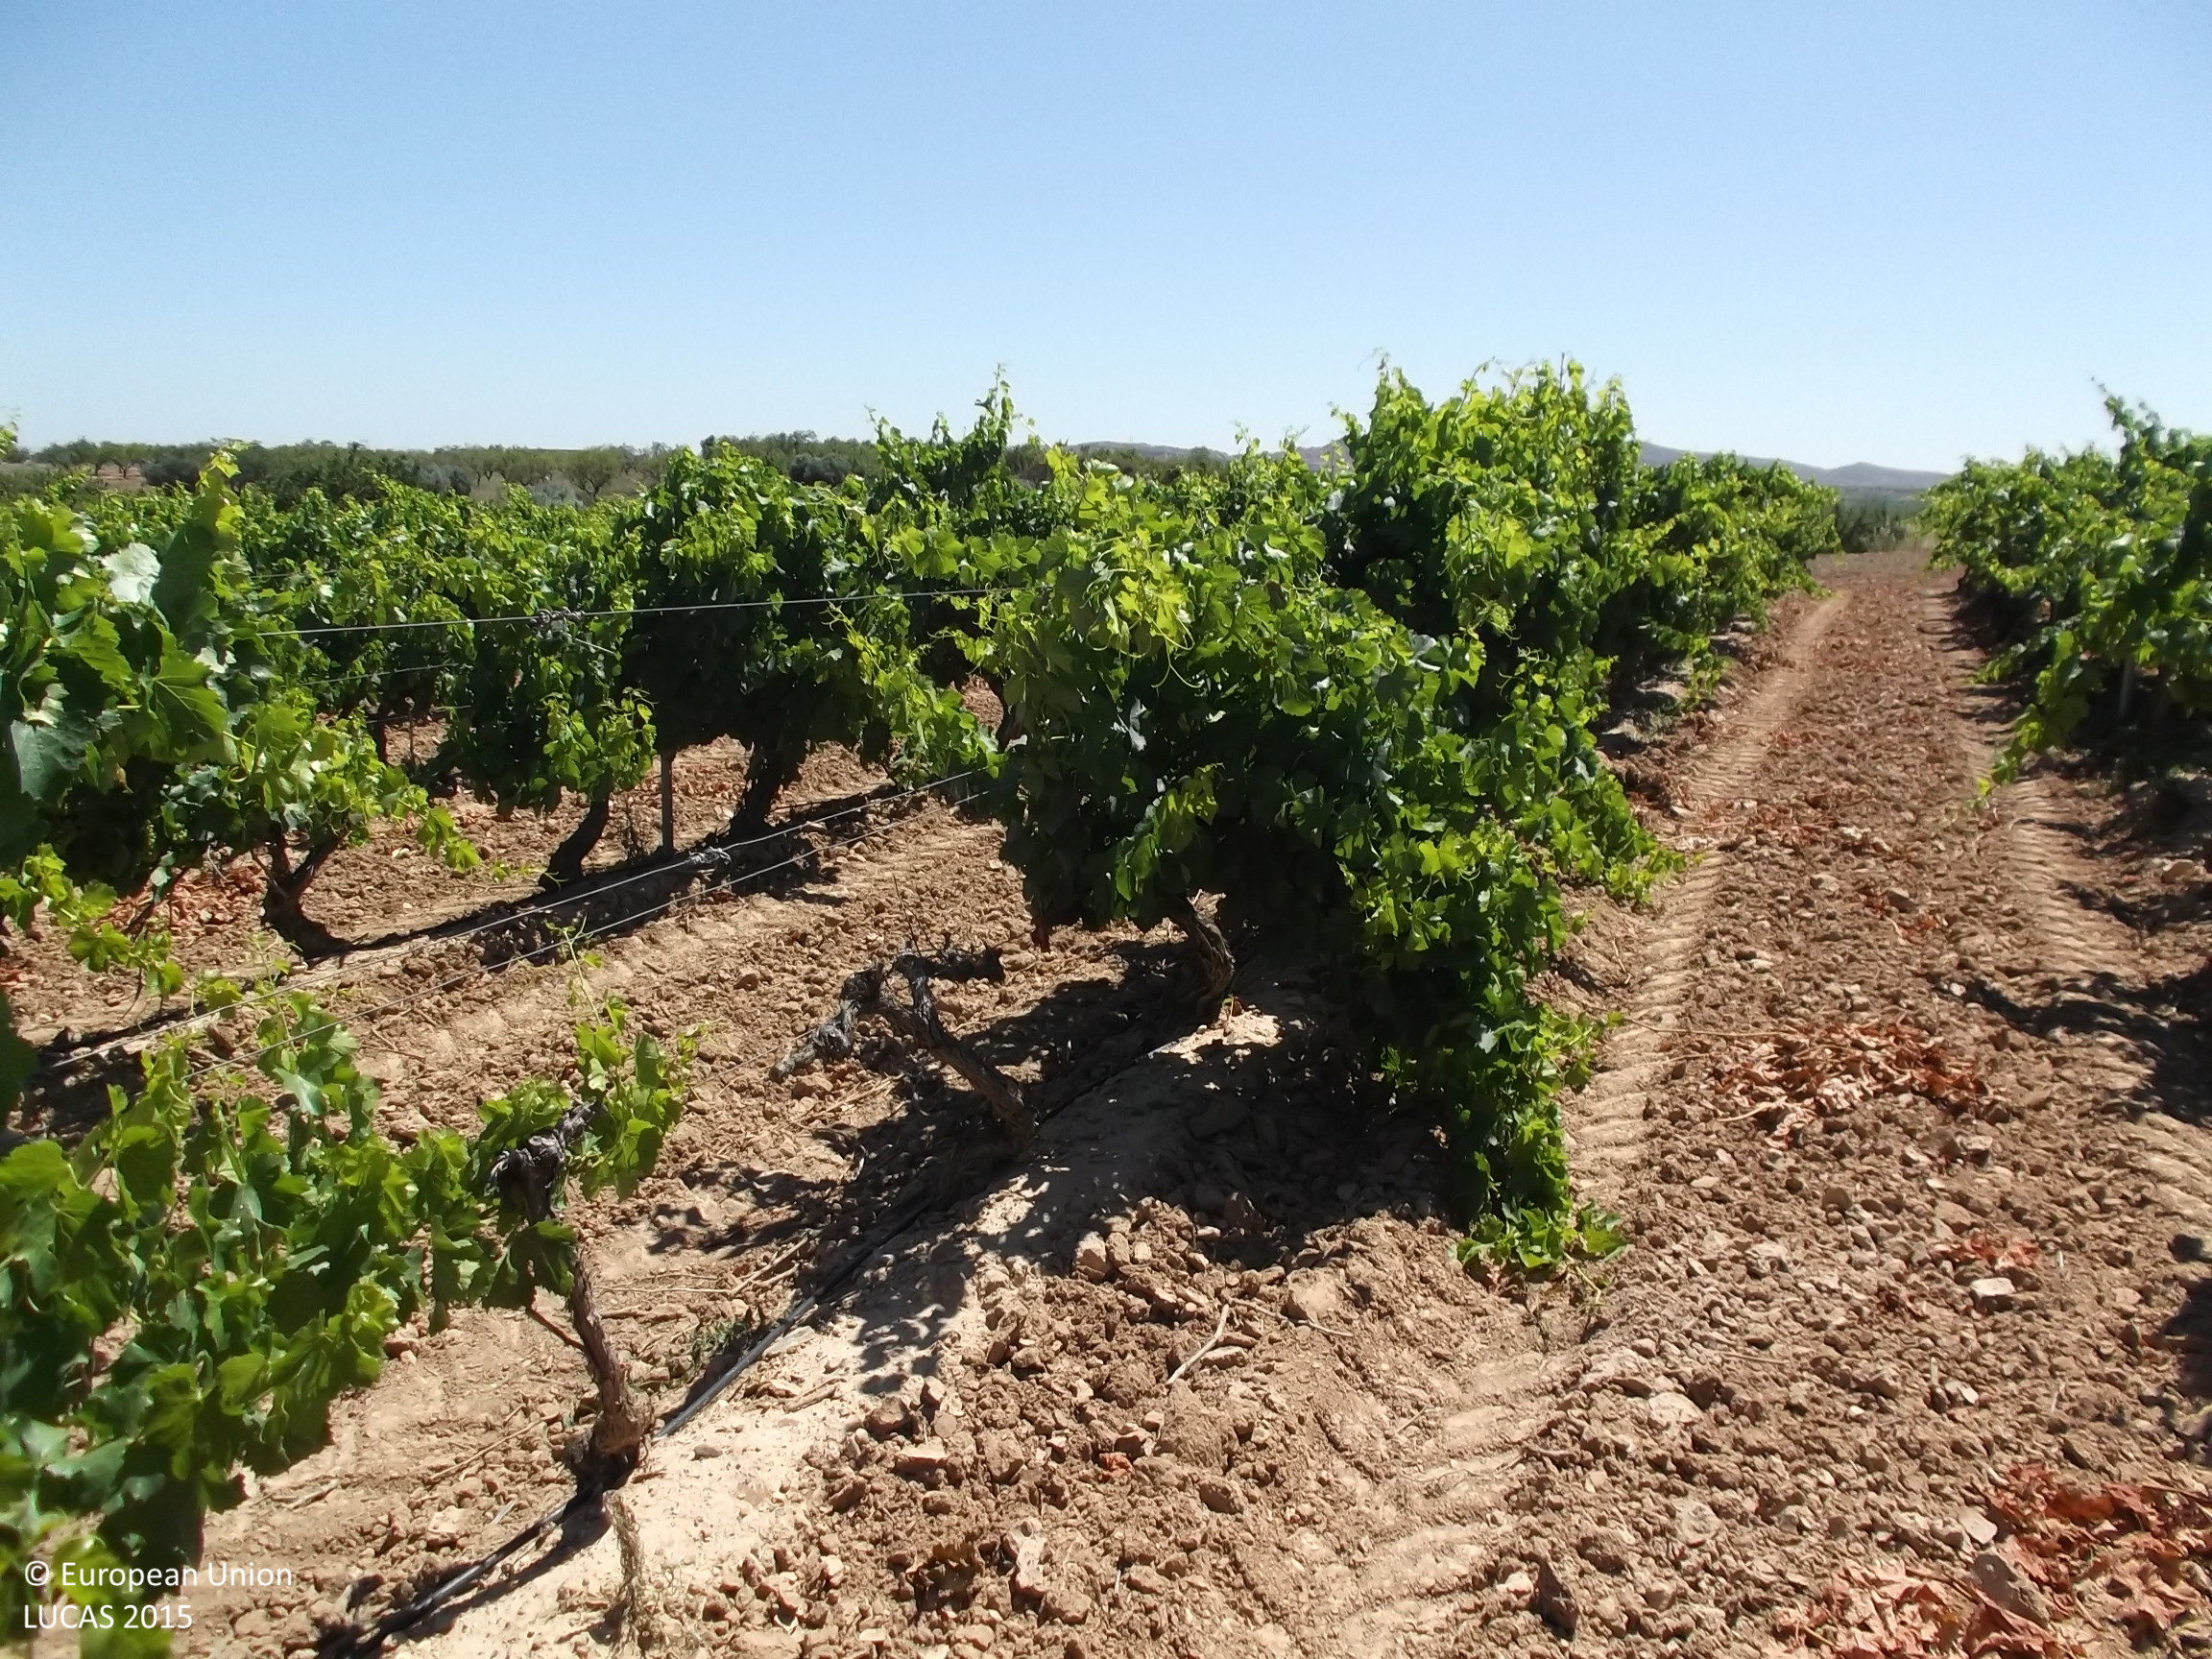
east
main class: Cropland
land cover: Vineyards
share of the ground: 25 - 50 %
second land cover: Other bare soil
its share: > 75 %
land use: Agriculture (excluding fallow land and kitchen gardens)
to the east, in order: Vineyards; Other bare soil; Grass margins; Cherry fruit; Shruby margins; Olive groves; Ditches and canals; Olive groves; Nuts trees; Tracks; Nuts trees
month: July
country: ES
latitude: 42.2600
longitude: -2.0515
